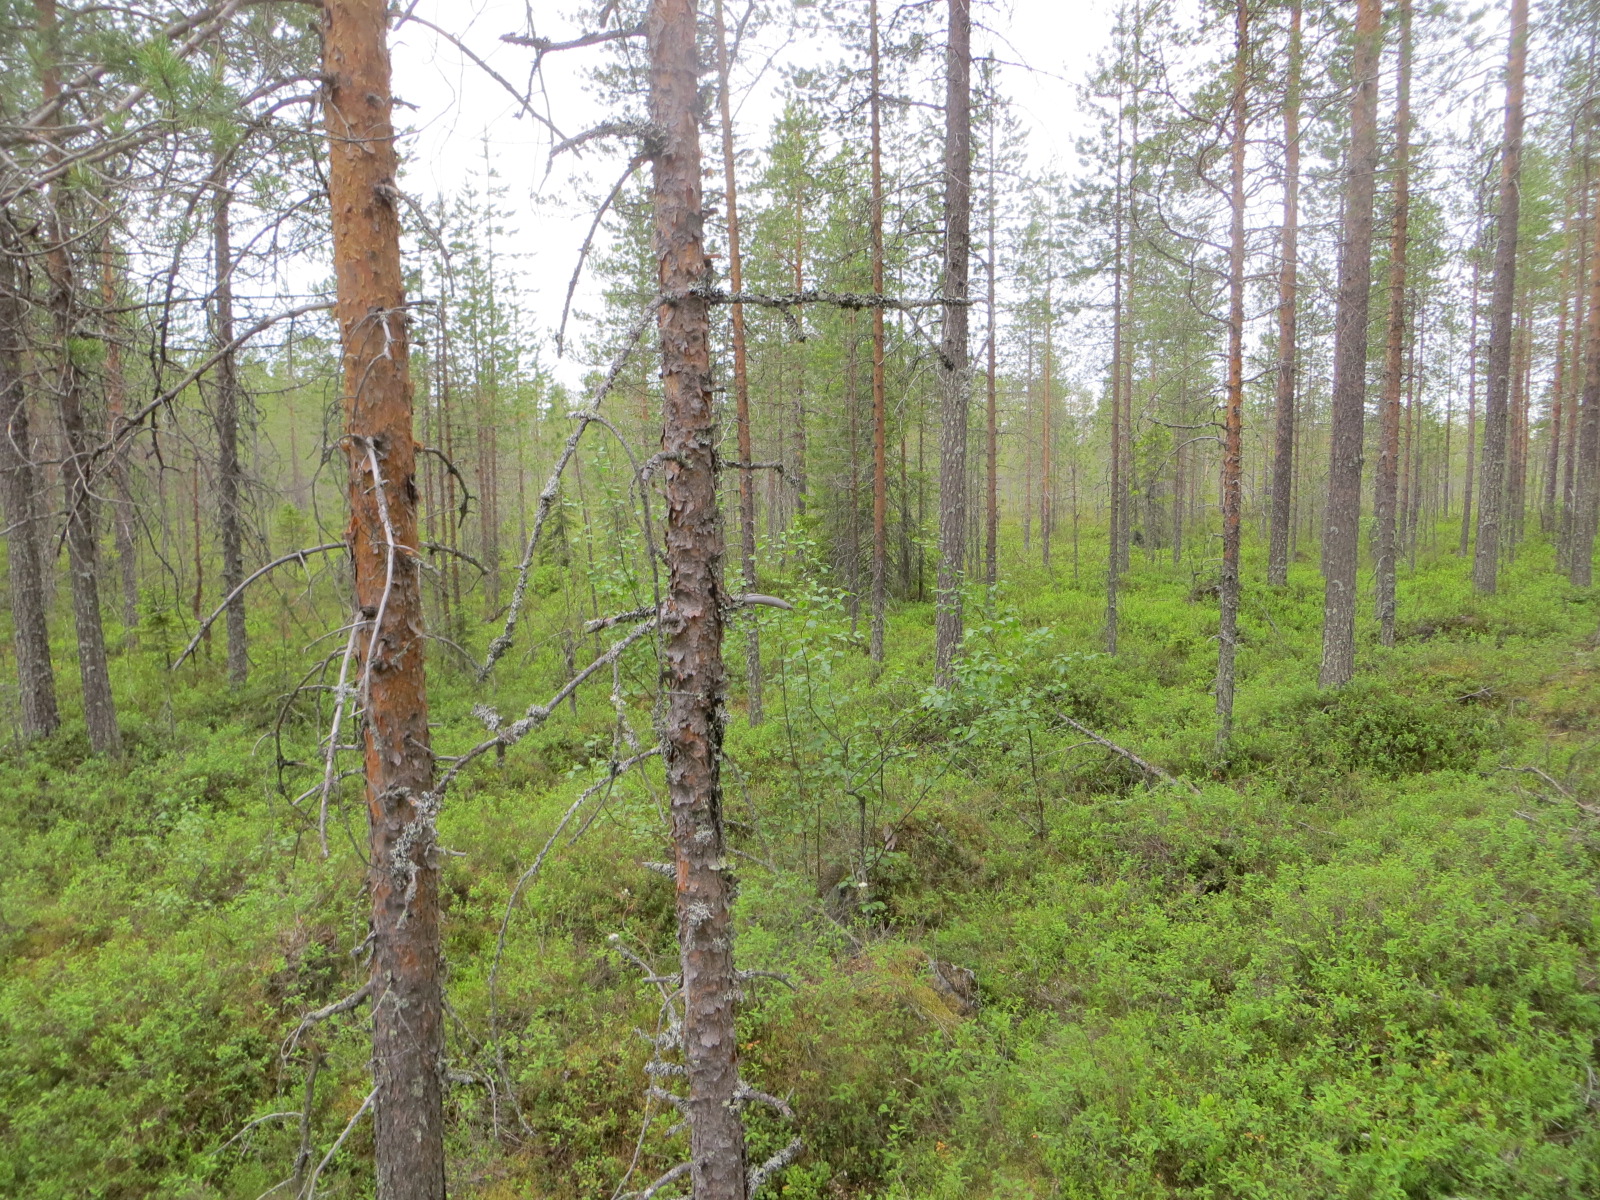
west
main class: Woodland
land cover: Pine dominated coniferous woodland
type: boreal forest
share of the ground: > 75 %
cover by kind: coniferous forest trees 75 %, shrubs 20 %, lichens and mosses 5 %
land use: Forestry
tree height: > 5 m
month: June
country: FI
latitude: 65.6194
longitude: 26.8923
